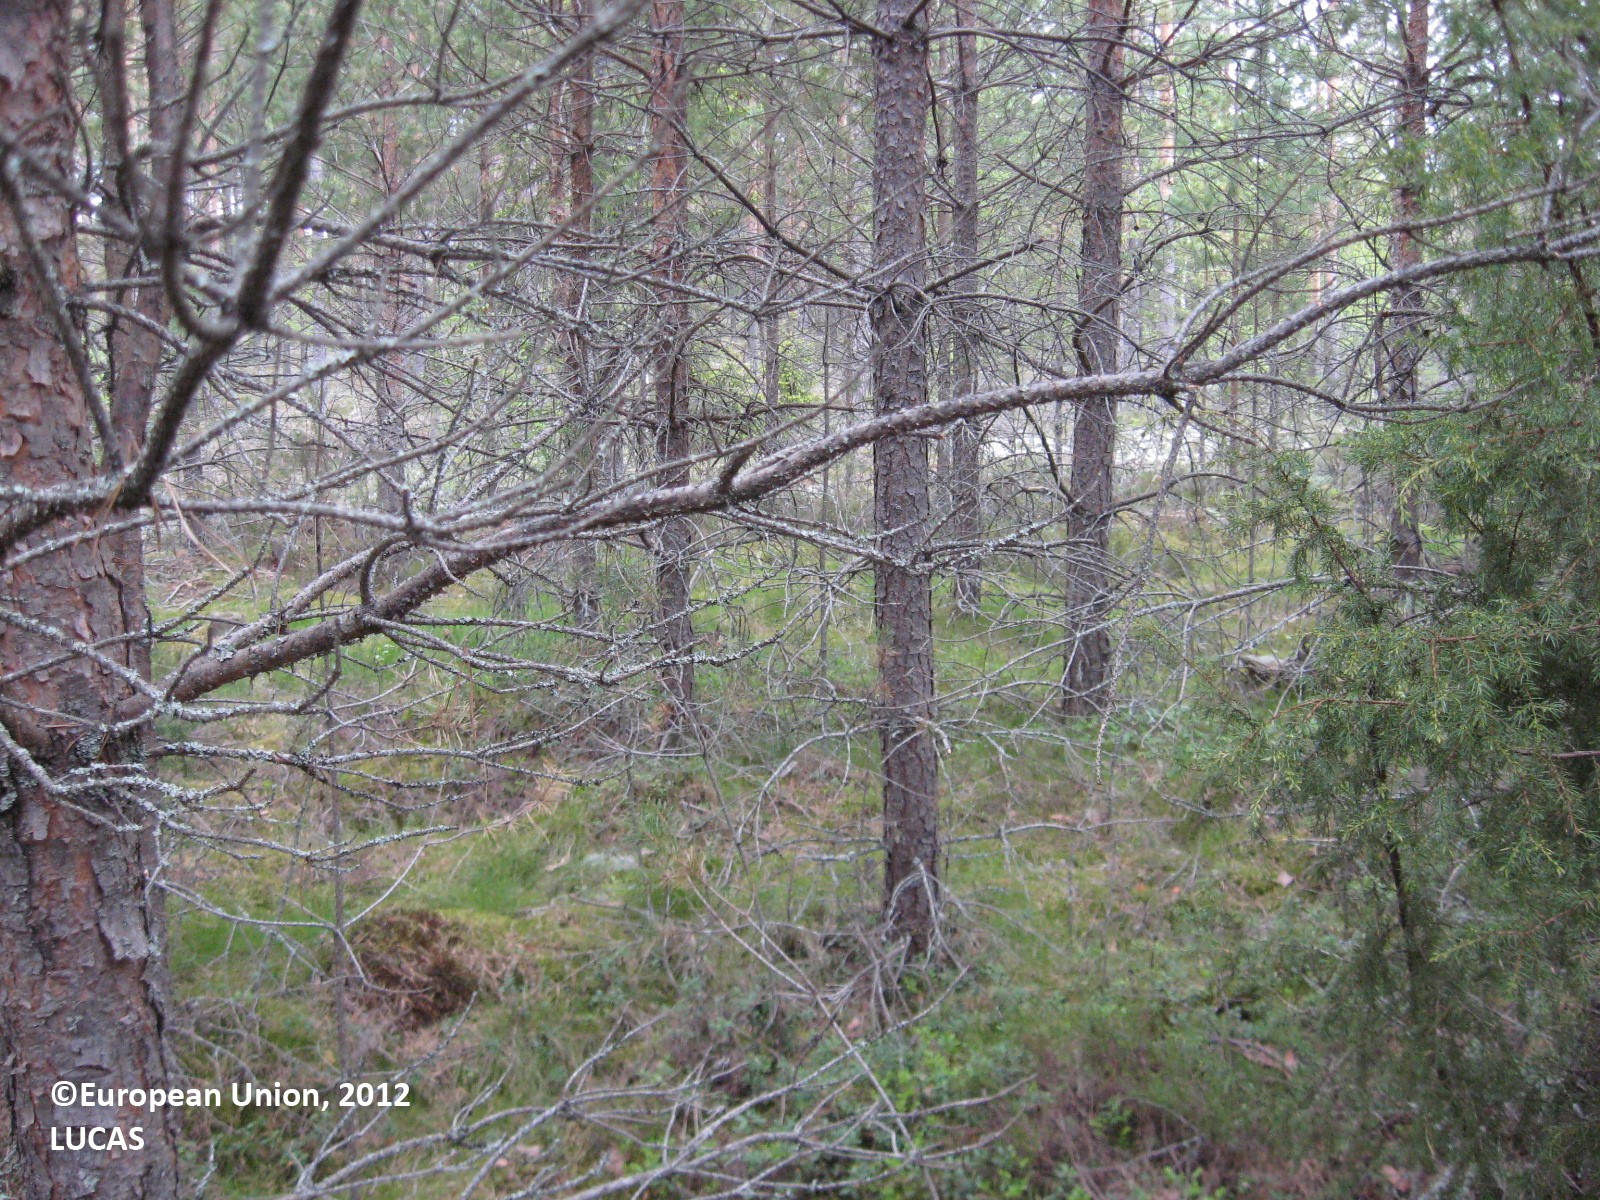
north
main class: Woodland
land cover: Pine dominated coniferous woodland
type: boreal forest
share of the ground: > 75 %
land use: Forestry
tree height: > 5 m
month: May
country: FI
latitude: 61.7687
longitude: 22.8197
